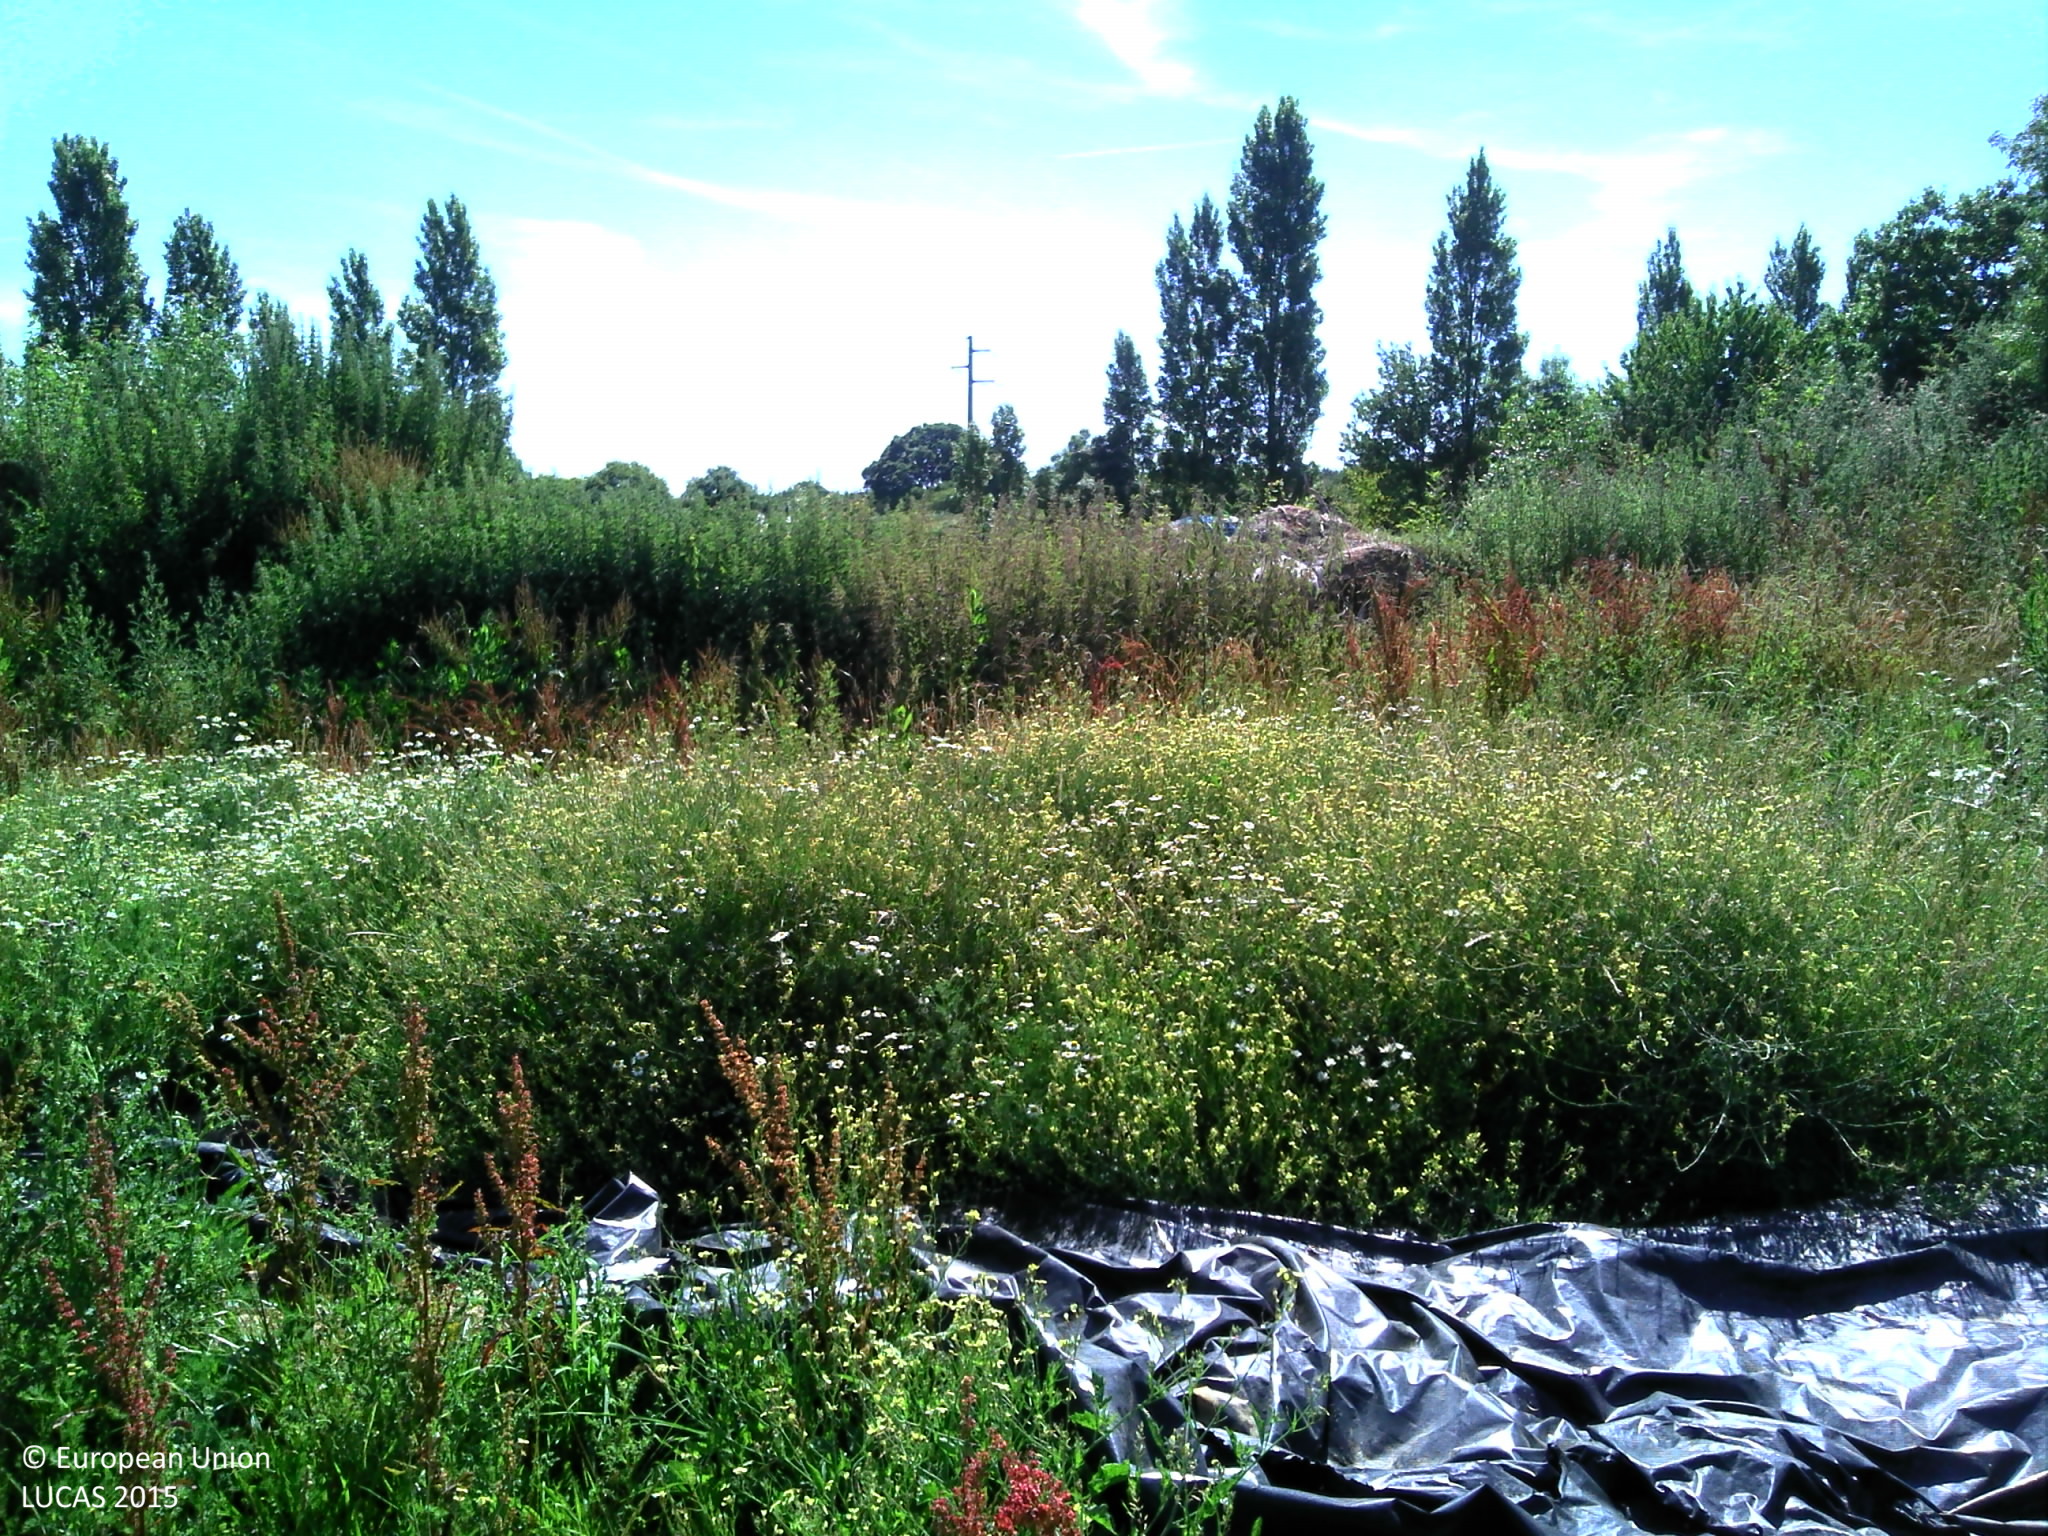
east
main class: Grassland
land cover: Spontaneously vegetated surfaces
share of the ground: > 75 %
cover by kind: herbaceous plants 95 %, unconsolidated bare surface 5 %
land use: Semi-natural and natural areas not in use
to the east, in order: Spontaneously vegetated surfaces; Fences; Grassland without tree/shrub cover; Lines of trees; Ditches and canals; Fences; Grassland without tree/shrub cover; Fences; Shrubland without tree cover; Mixed cereals for fodder; Electric lines; Mixed cereals for fodder; Fences; Shrubland with sparse tree cover; Ditches and canals; Grass margins; Tracks; Grass margins; Ditches and canals; Shrubland with sparse tree cover; Tracks; Spontaneously vegetated surfaces
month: June
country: FR
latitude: 47.1962
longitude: -2.0470
